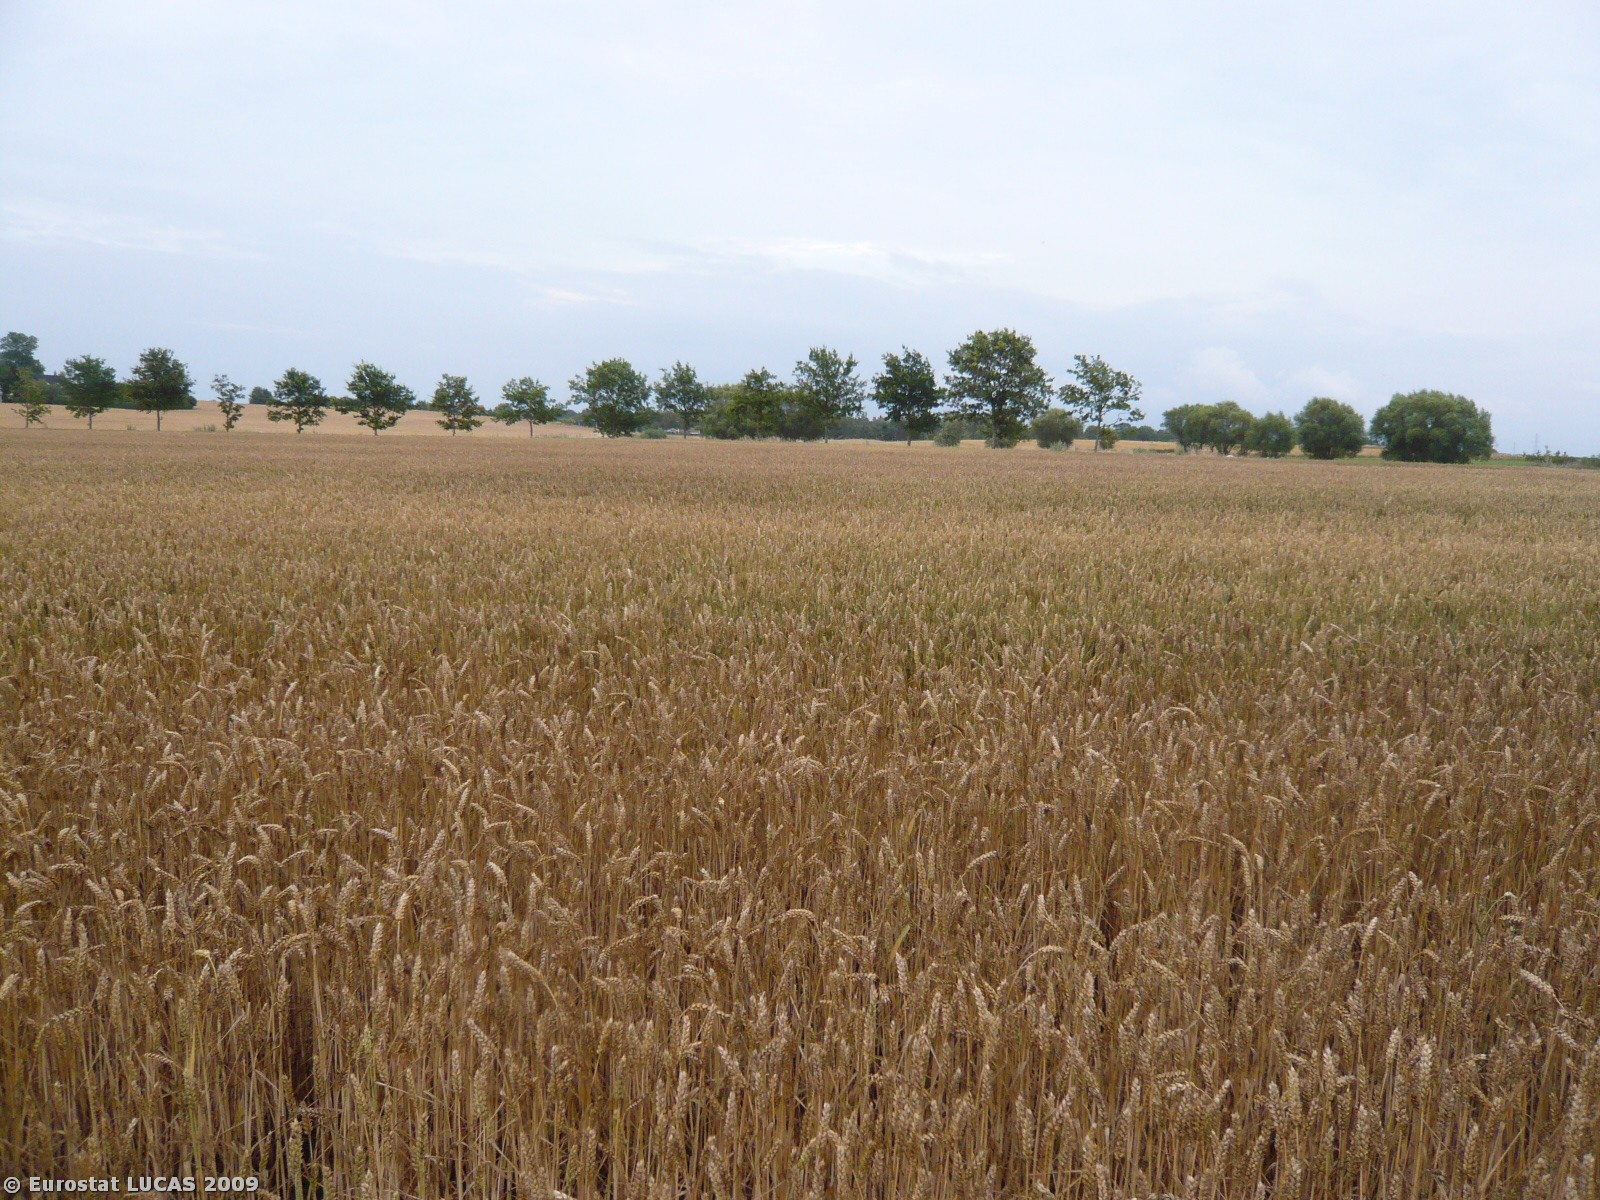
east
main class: Cropland
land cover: Common wheat
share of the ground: > 75 %
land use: Agriculture (excluding fallow land and kitchen gardens)
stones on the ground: 25 - 50 %
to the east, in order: Common wheat; Tracks; Common wheat; Lines of trees; Tracks; Common wheat
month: July
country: DK
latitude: 55.8122
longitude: 12.0247
